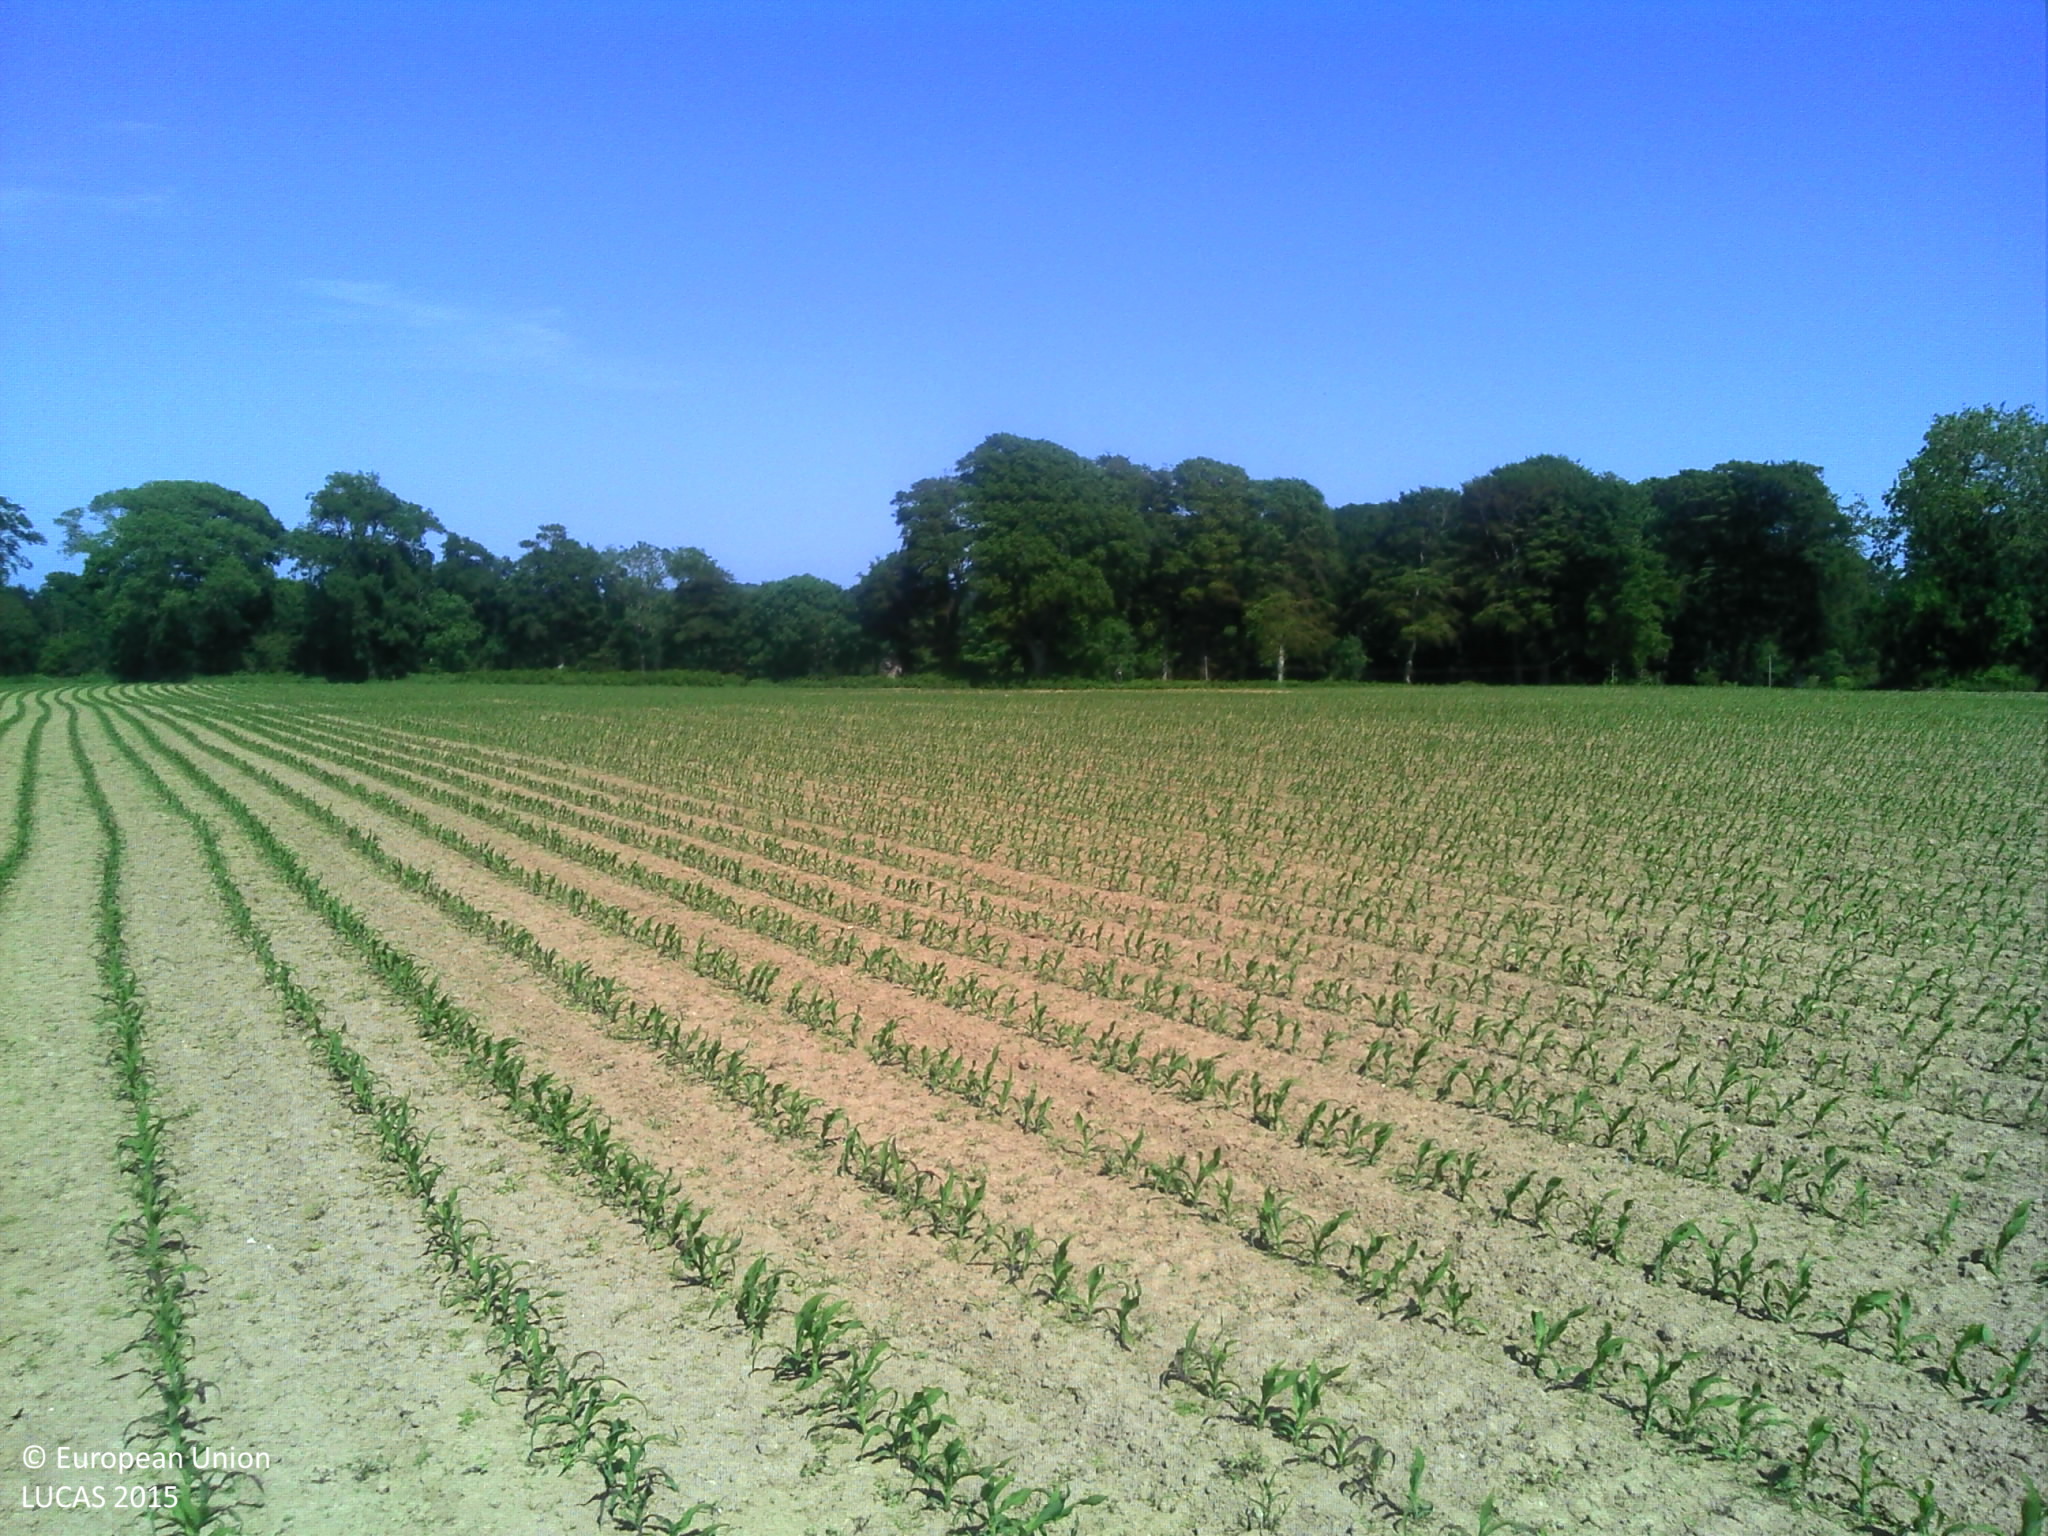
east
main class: Cropland
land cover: Maize
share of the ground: 10 - 25 %
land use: Agriculture (excluding fallow land and kitchen gardens)
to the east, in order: Maize; Lines of trees; Electric lines; Grass margins; Paved roads, cycling and walking lanes; Grass margins; Lines of trees; Grassland without tree/shrub cover
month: June
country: FR
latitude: 49.6597
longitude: -1.4502
